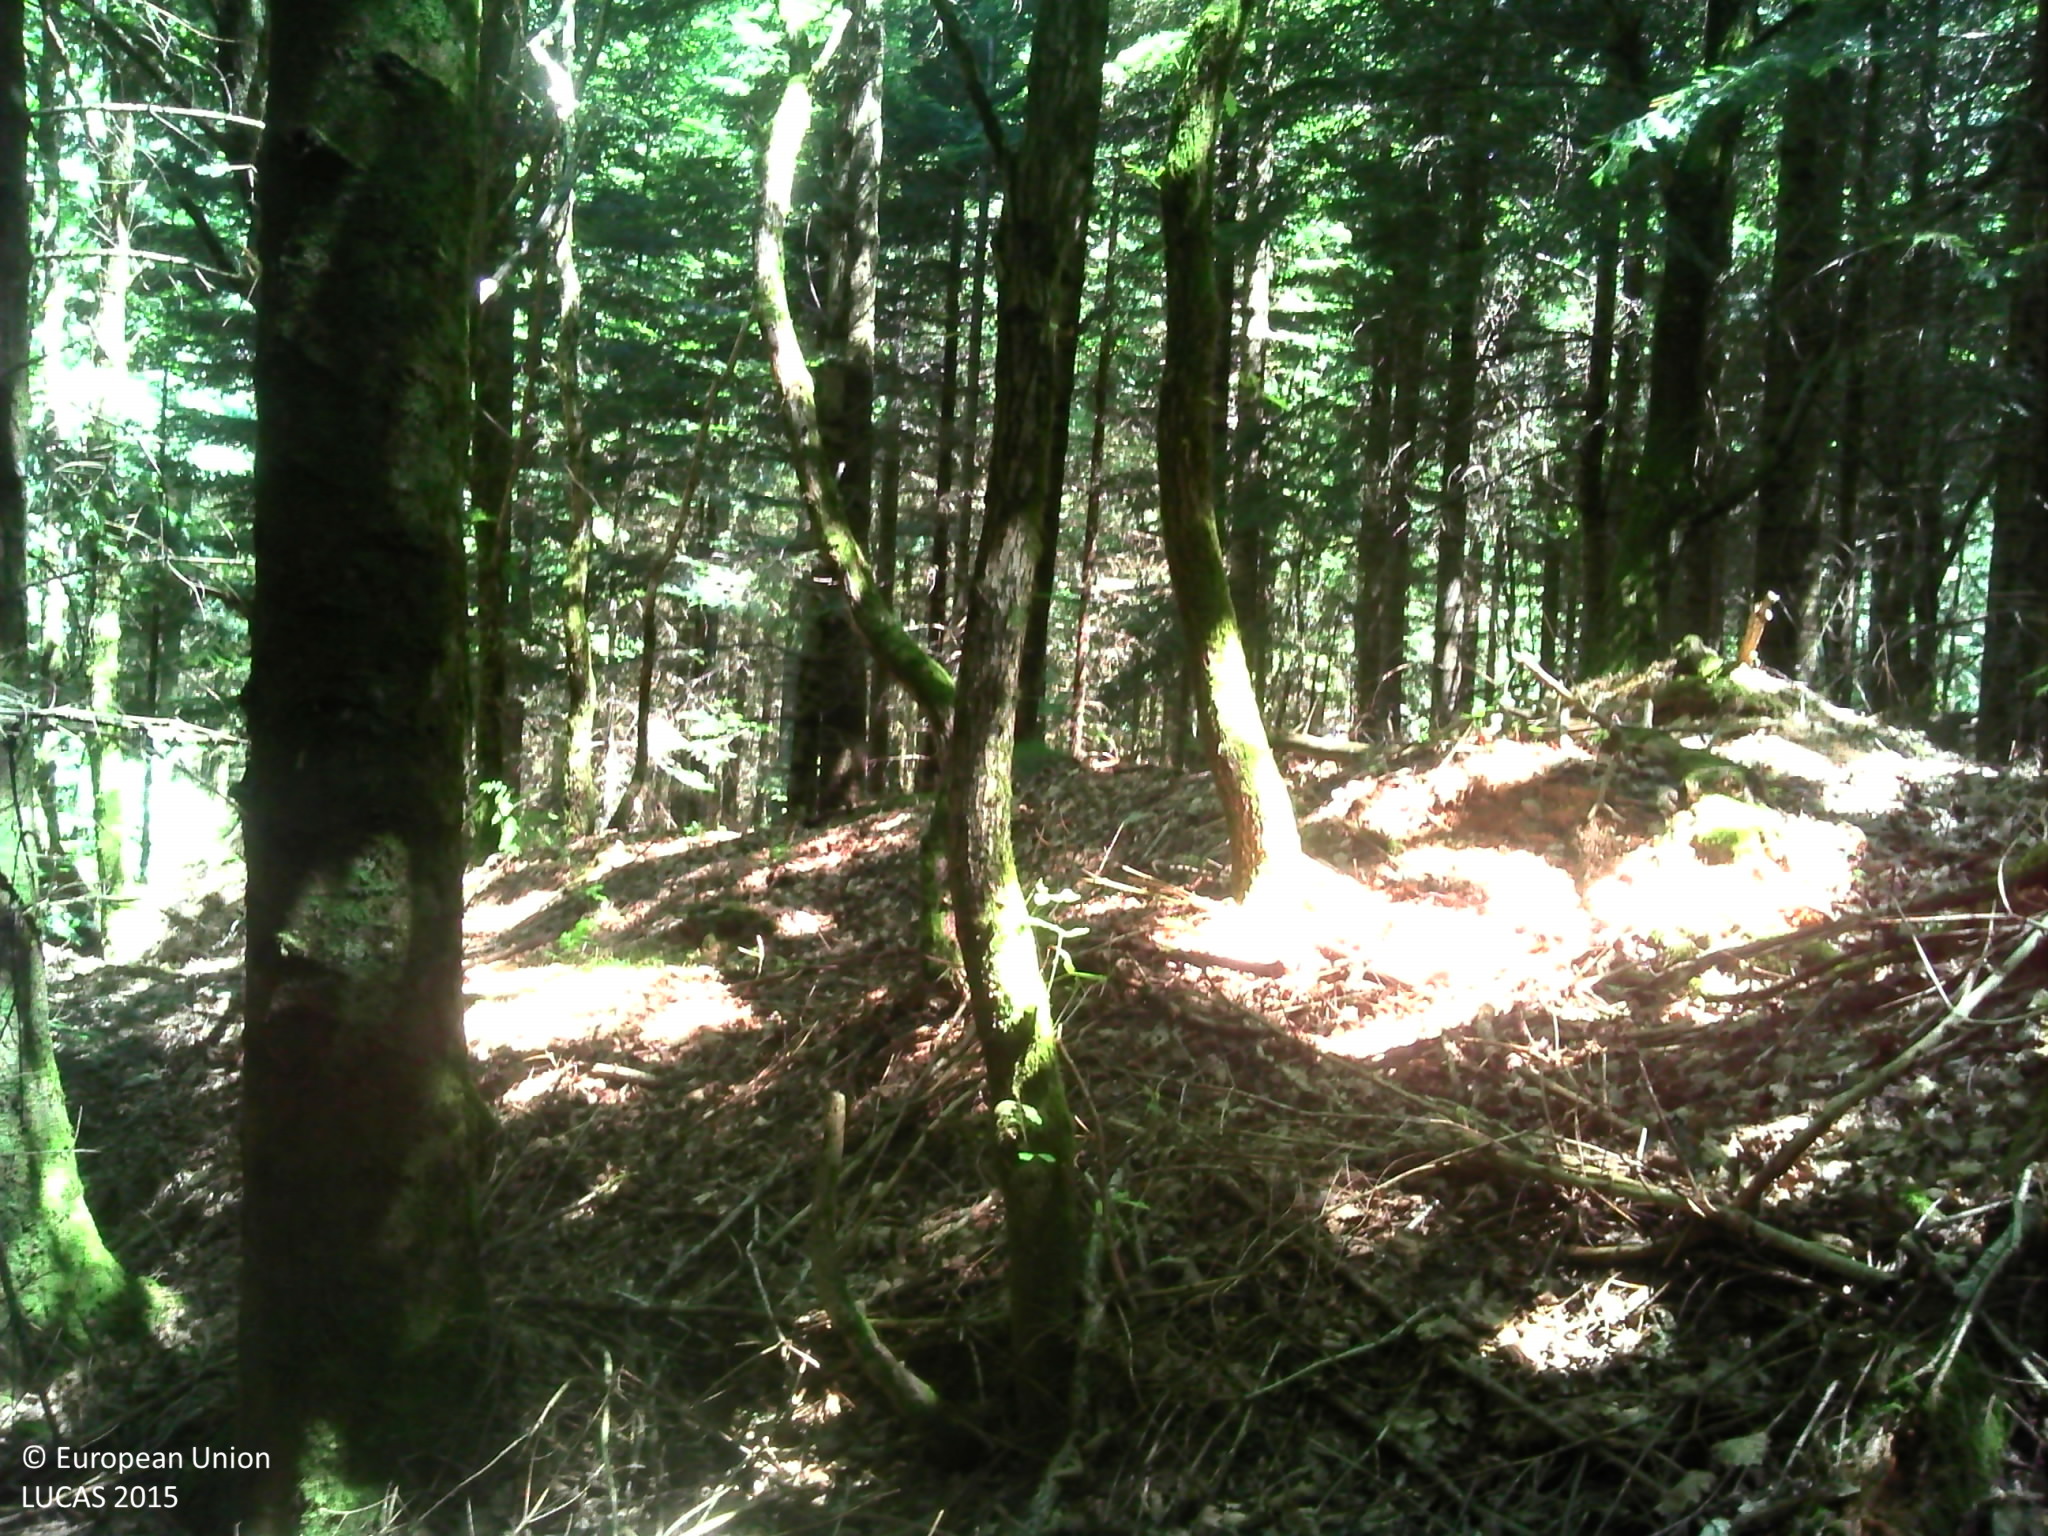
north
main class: Woodland
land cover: Spruce dominated coniferous woodland
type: exotic forest
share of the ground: > 75 %
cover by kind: coniferous forest trees 100 %
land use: Forestry
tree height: > 5 m
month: June
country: FR
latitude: 43.7577
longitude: 2.5662
